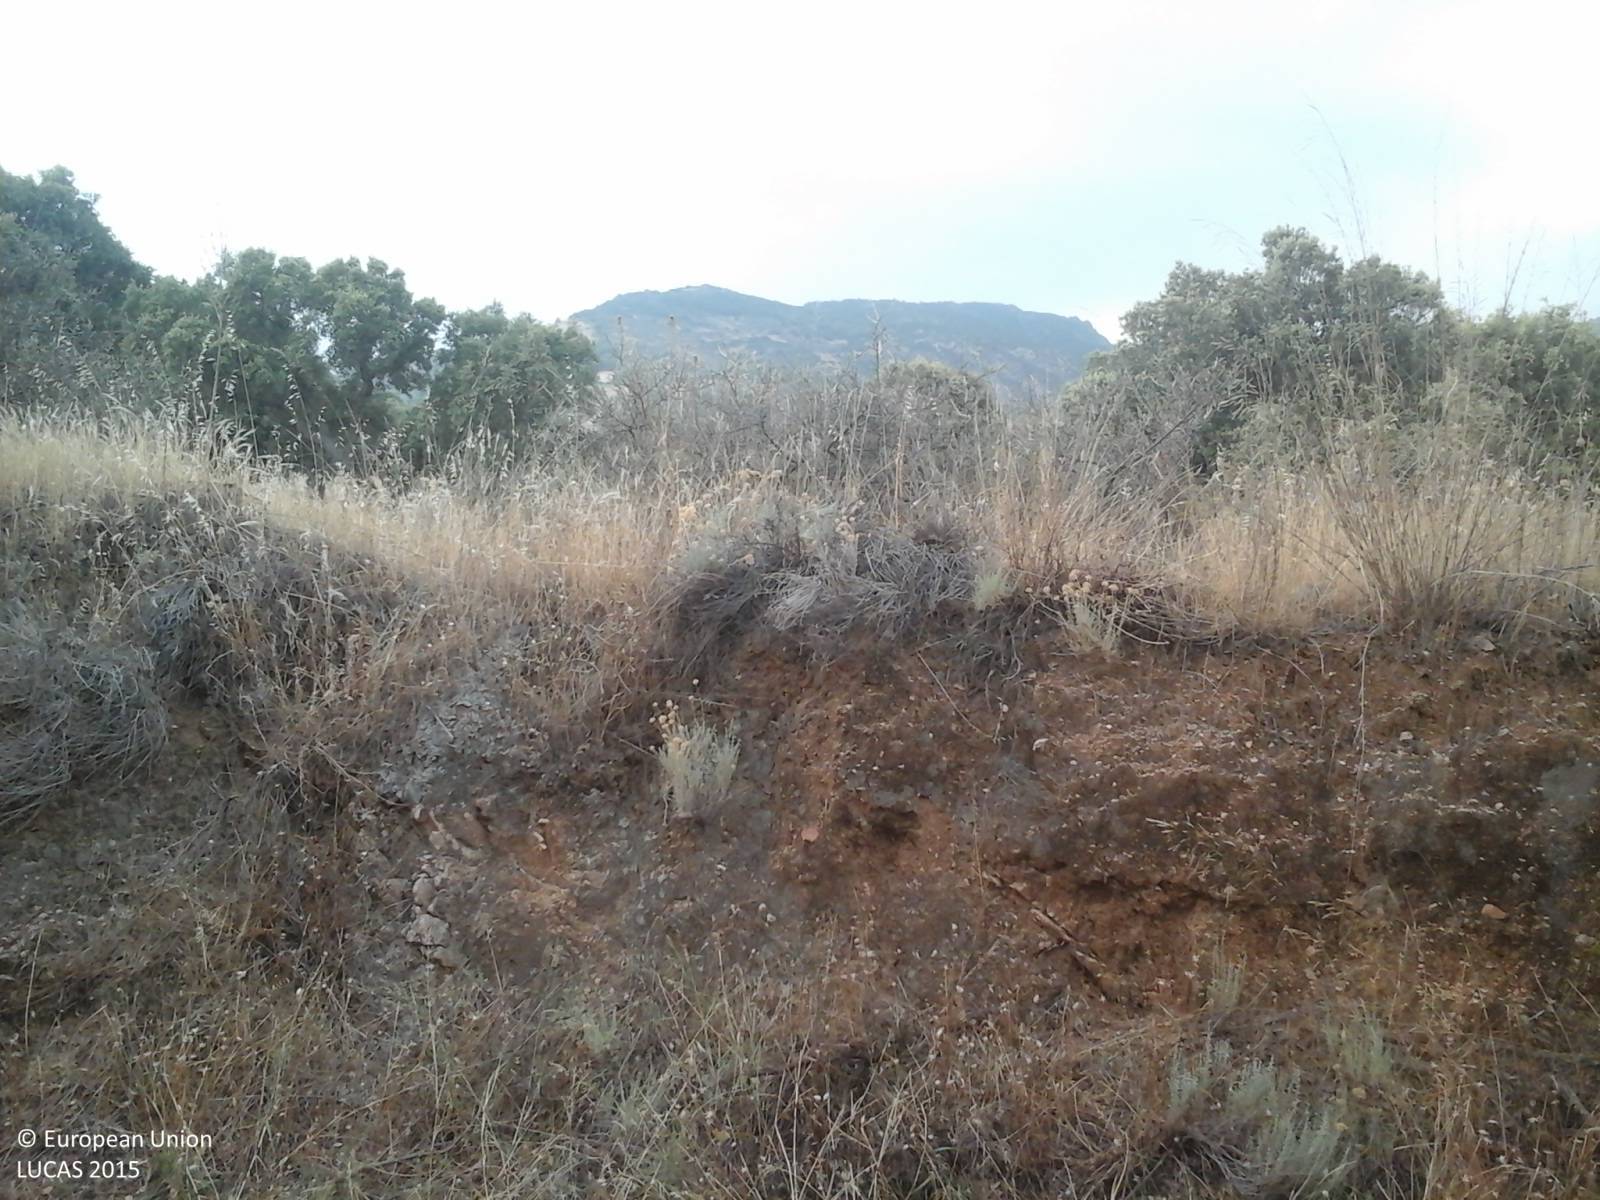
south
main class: Woodland
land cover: Broadleaved woodland
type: broadleaved evergreen forest
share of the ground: > 75 %
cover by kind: broadleaved forest trees 60 %, shrubs 25 %, herbaceous plants 10 %, unconsolidated bare surface 5 %
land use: Semi-natural and natural areas not in use
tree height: > 5 m
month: July
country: IT
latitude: 40.7906
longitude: 9.4457
